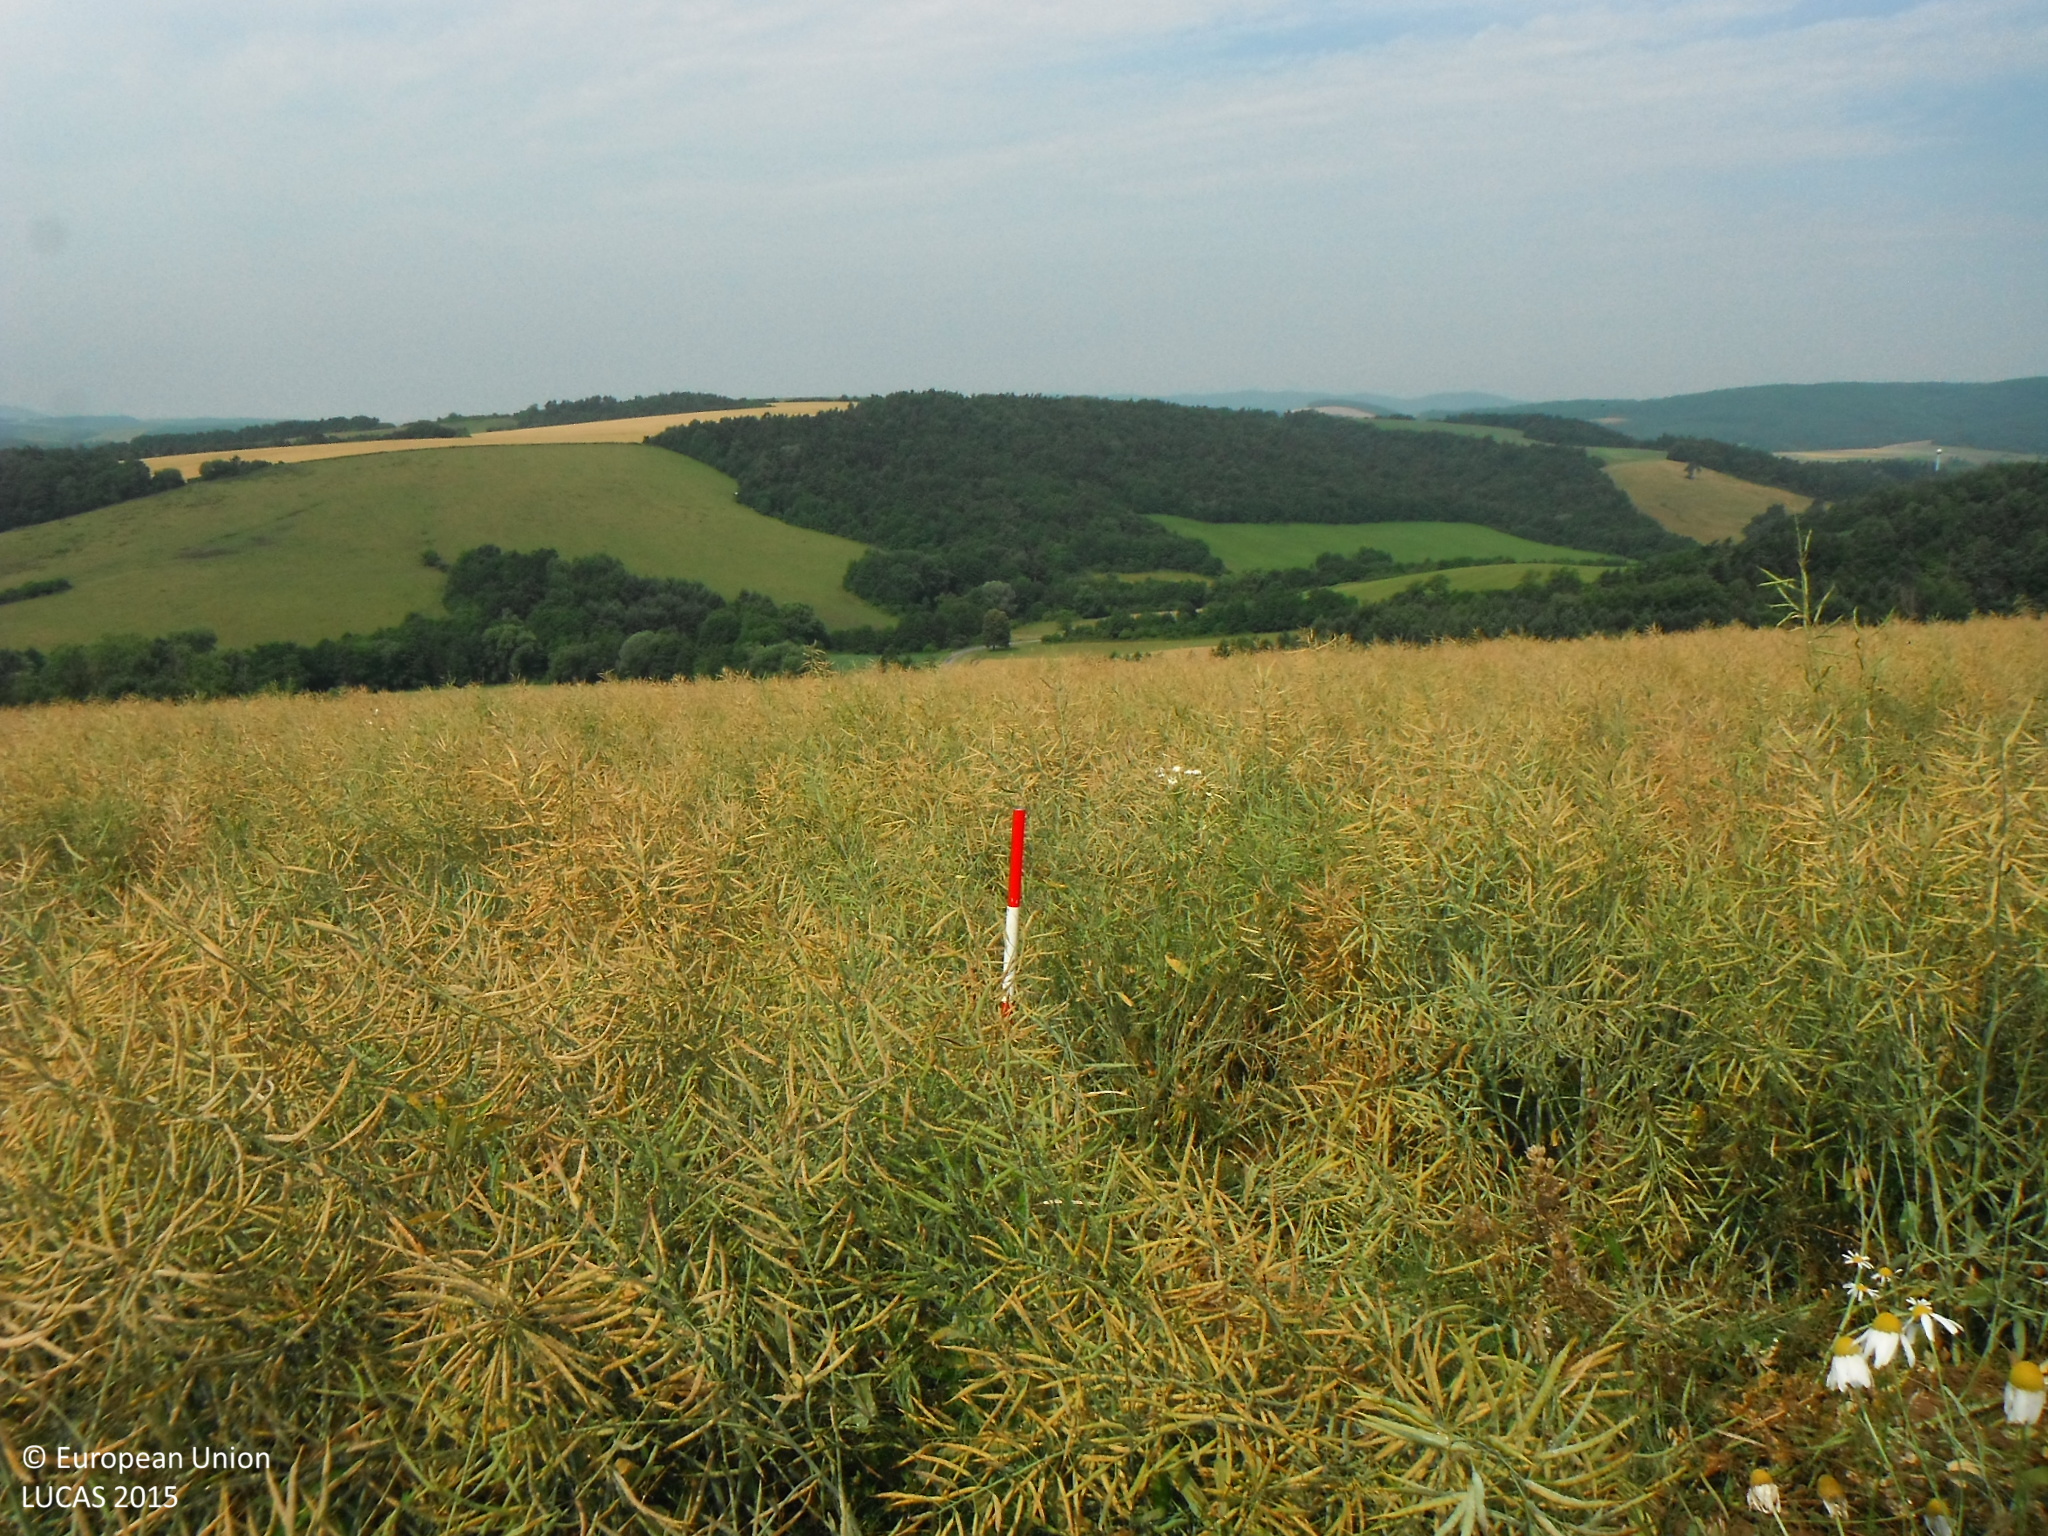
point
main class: Cropland
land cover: Rape and turnip rape
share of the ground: > 75 %
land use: Agriculture (excluding fallow land and kitchen gardens)
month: July
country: SK
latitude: 49.1725
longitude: 21.4186
